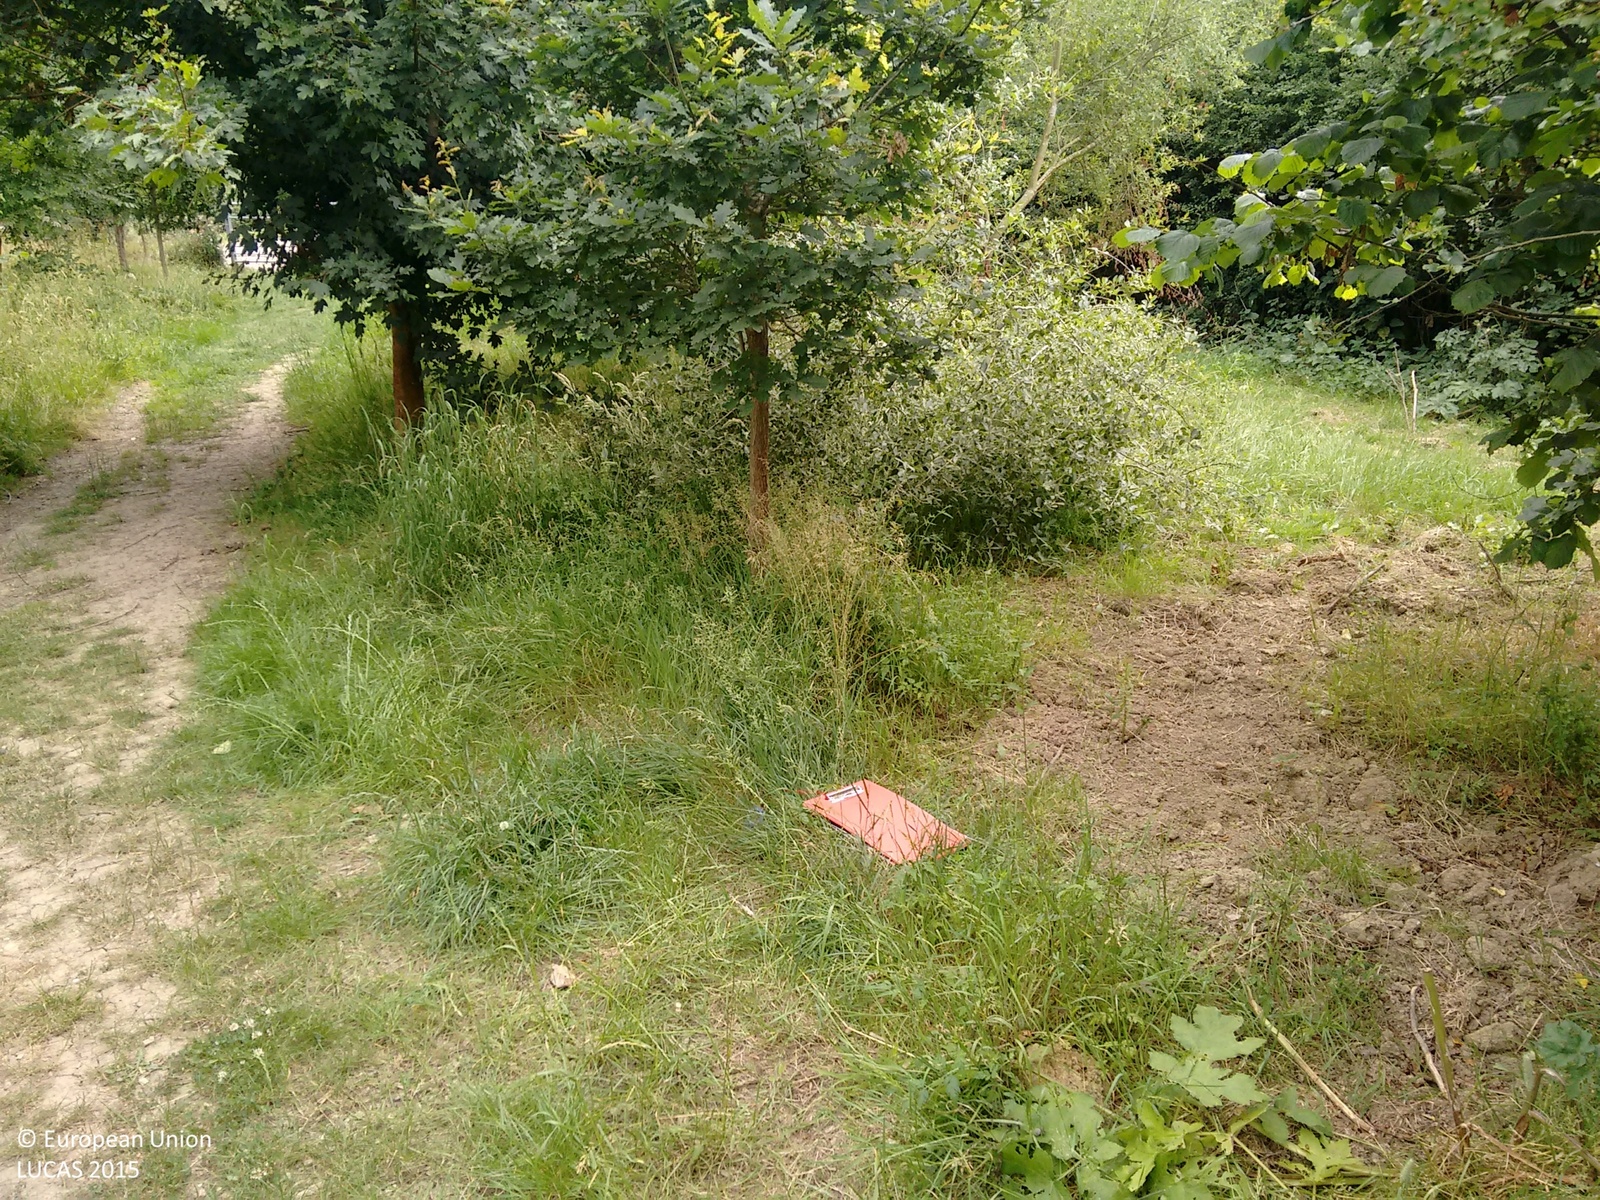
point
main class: Woodland
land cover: Broadleaved woodland
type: mesophytic deciduous forest
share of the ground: > 75 %
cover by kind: broadleaved forest trees 75 %, herbaceous plants 25 %
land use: Agriculture (excluding fallow land and kitchen gardens)
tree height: > 5 m
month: July
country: GB
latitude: 51.0306
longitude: -0.4036
